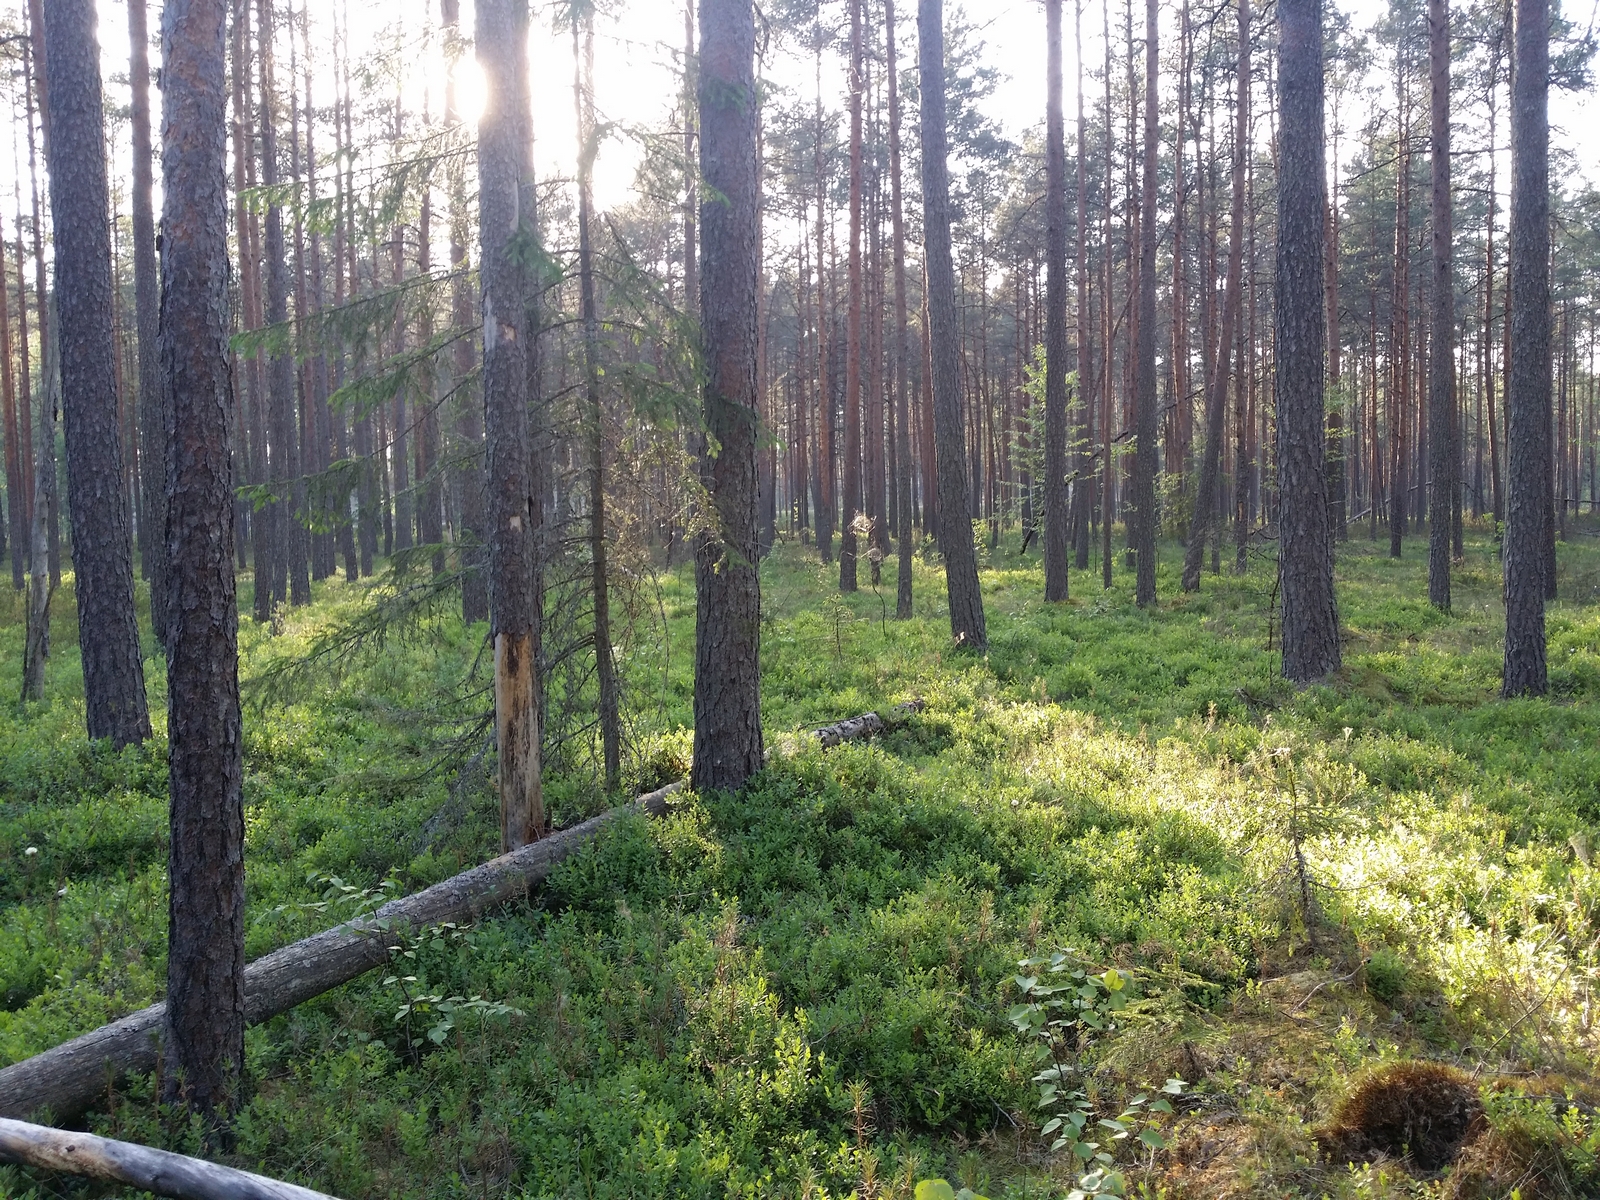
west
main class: Woodland
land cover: Other coniferous woodland
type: hemiboreal forest and nemoral coniferous forest and mixed broadleaved-coniferous forest
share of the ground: > 75 %
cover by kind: coniferous forest trees 80 %, lichens and mosses 20 %
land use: Forestry
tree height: > 5 m
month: June
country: LV
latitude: 57.2787
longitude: 26.5156
